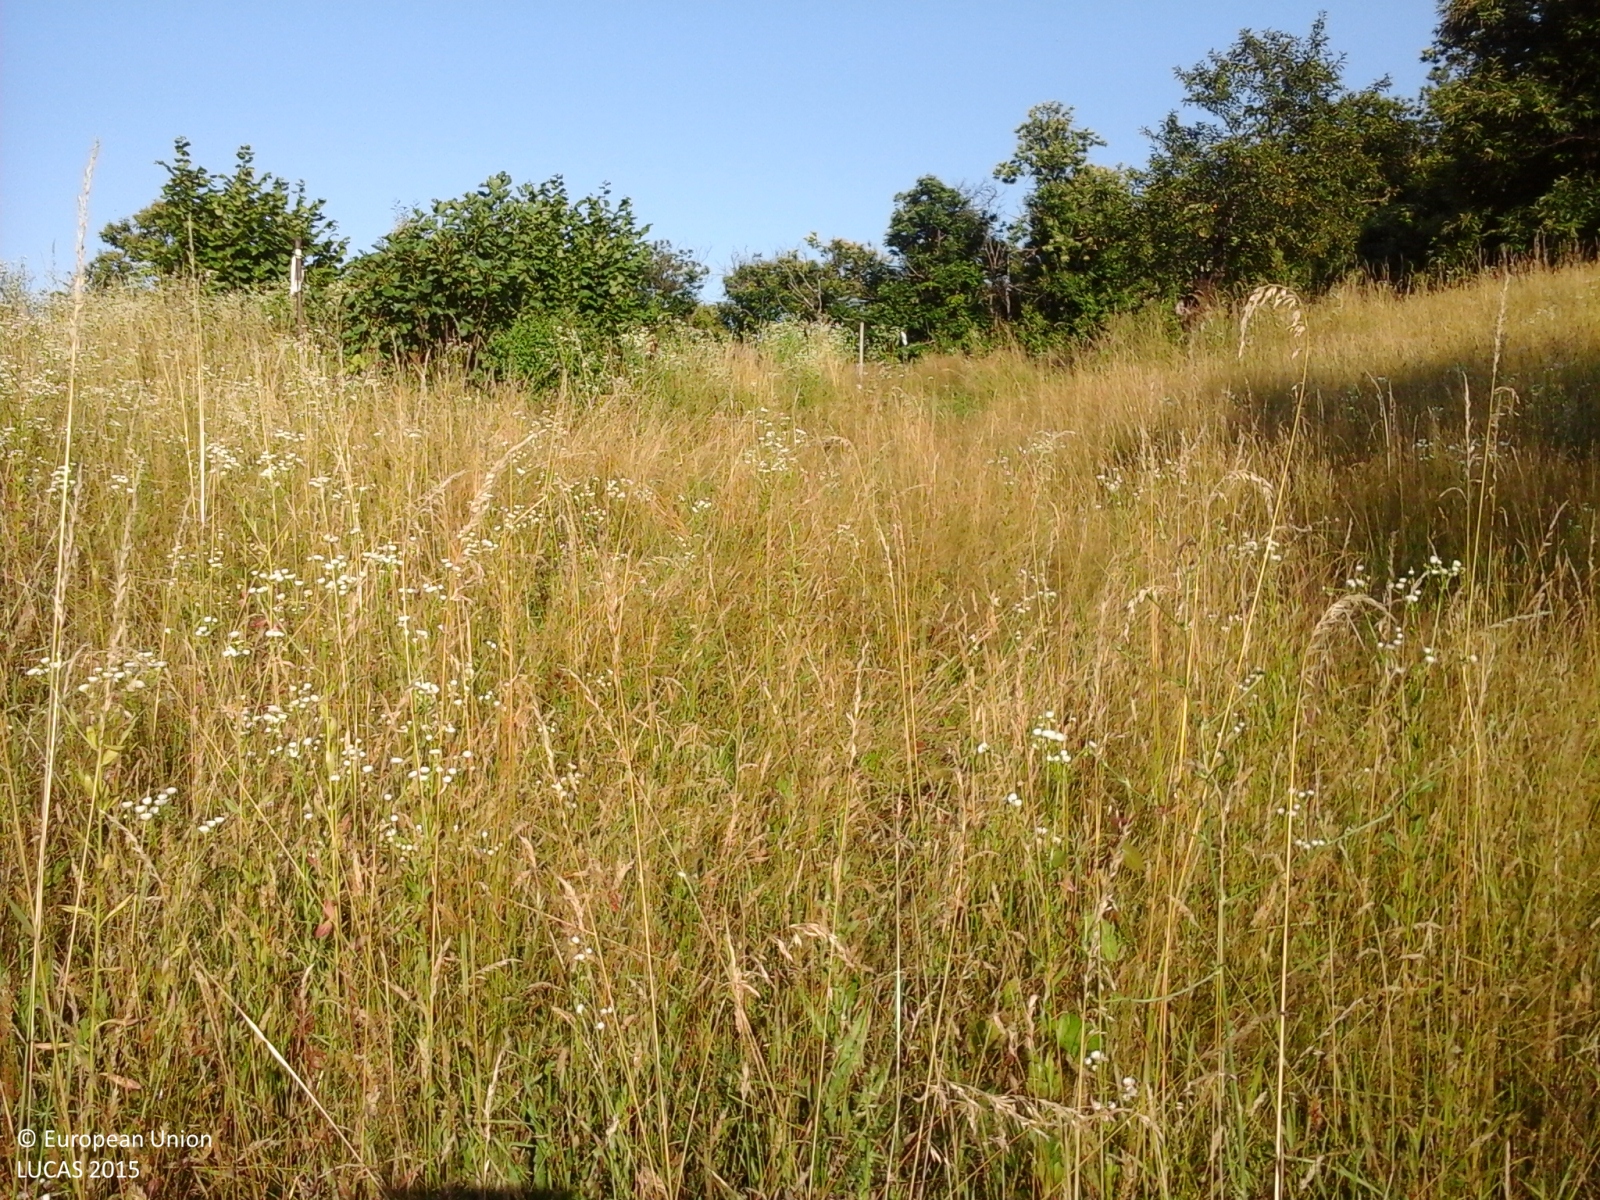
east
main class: Grassland
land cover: Grassland without tree/shrub cover
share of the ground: > 75 %
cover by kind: herbaceous plants 100 %
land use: Agriculture (excluding fallow land and kitchen gardens)
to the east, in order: Grassland without tree/shrub cover; Nuts trees; Grassland without tree/shrub cover; Other fruit trees and berries; Shrubland with sparse tree cover; Broadleaved woodland; Tracks; Broadleaved woodland; Tracks; Nuts trees; Grassland with sparse tree/shrub cover; Broadleaved woodland
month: June
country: IT
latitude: 44.3460
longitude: 7.8346
